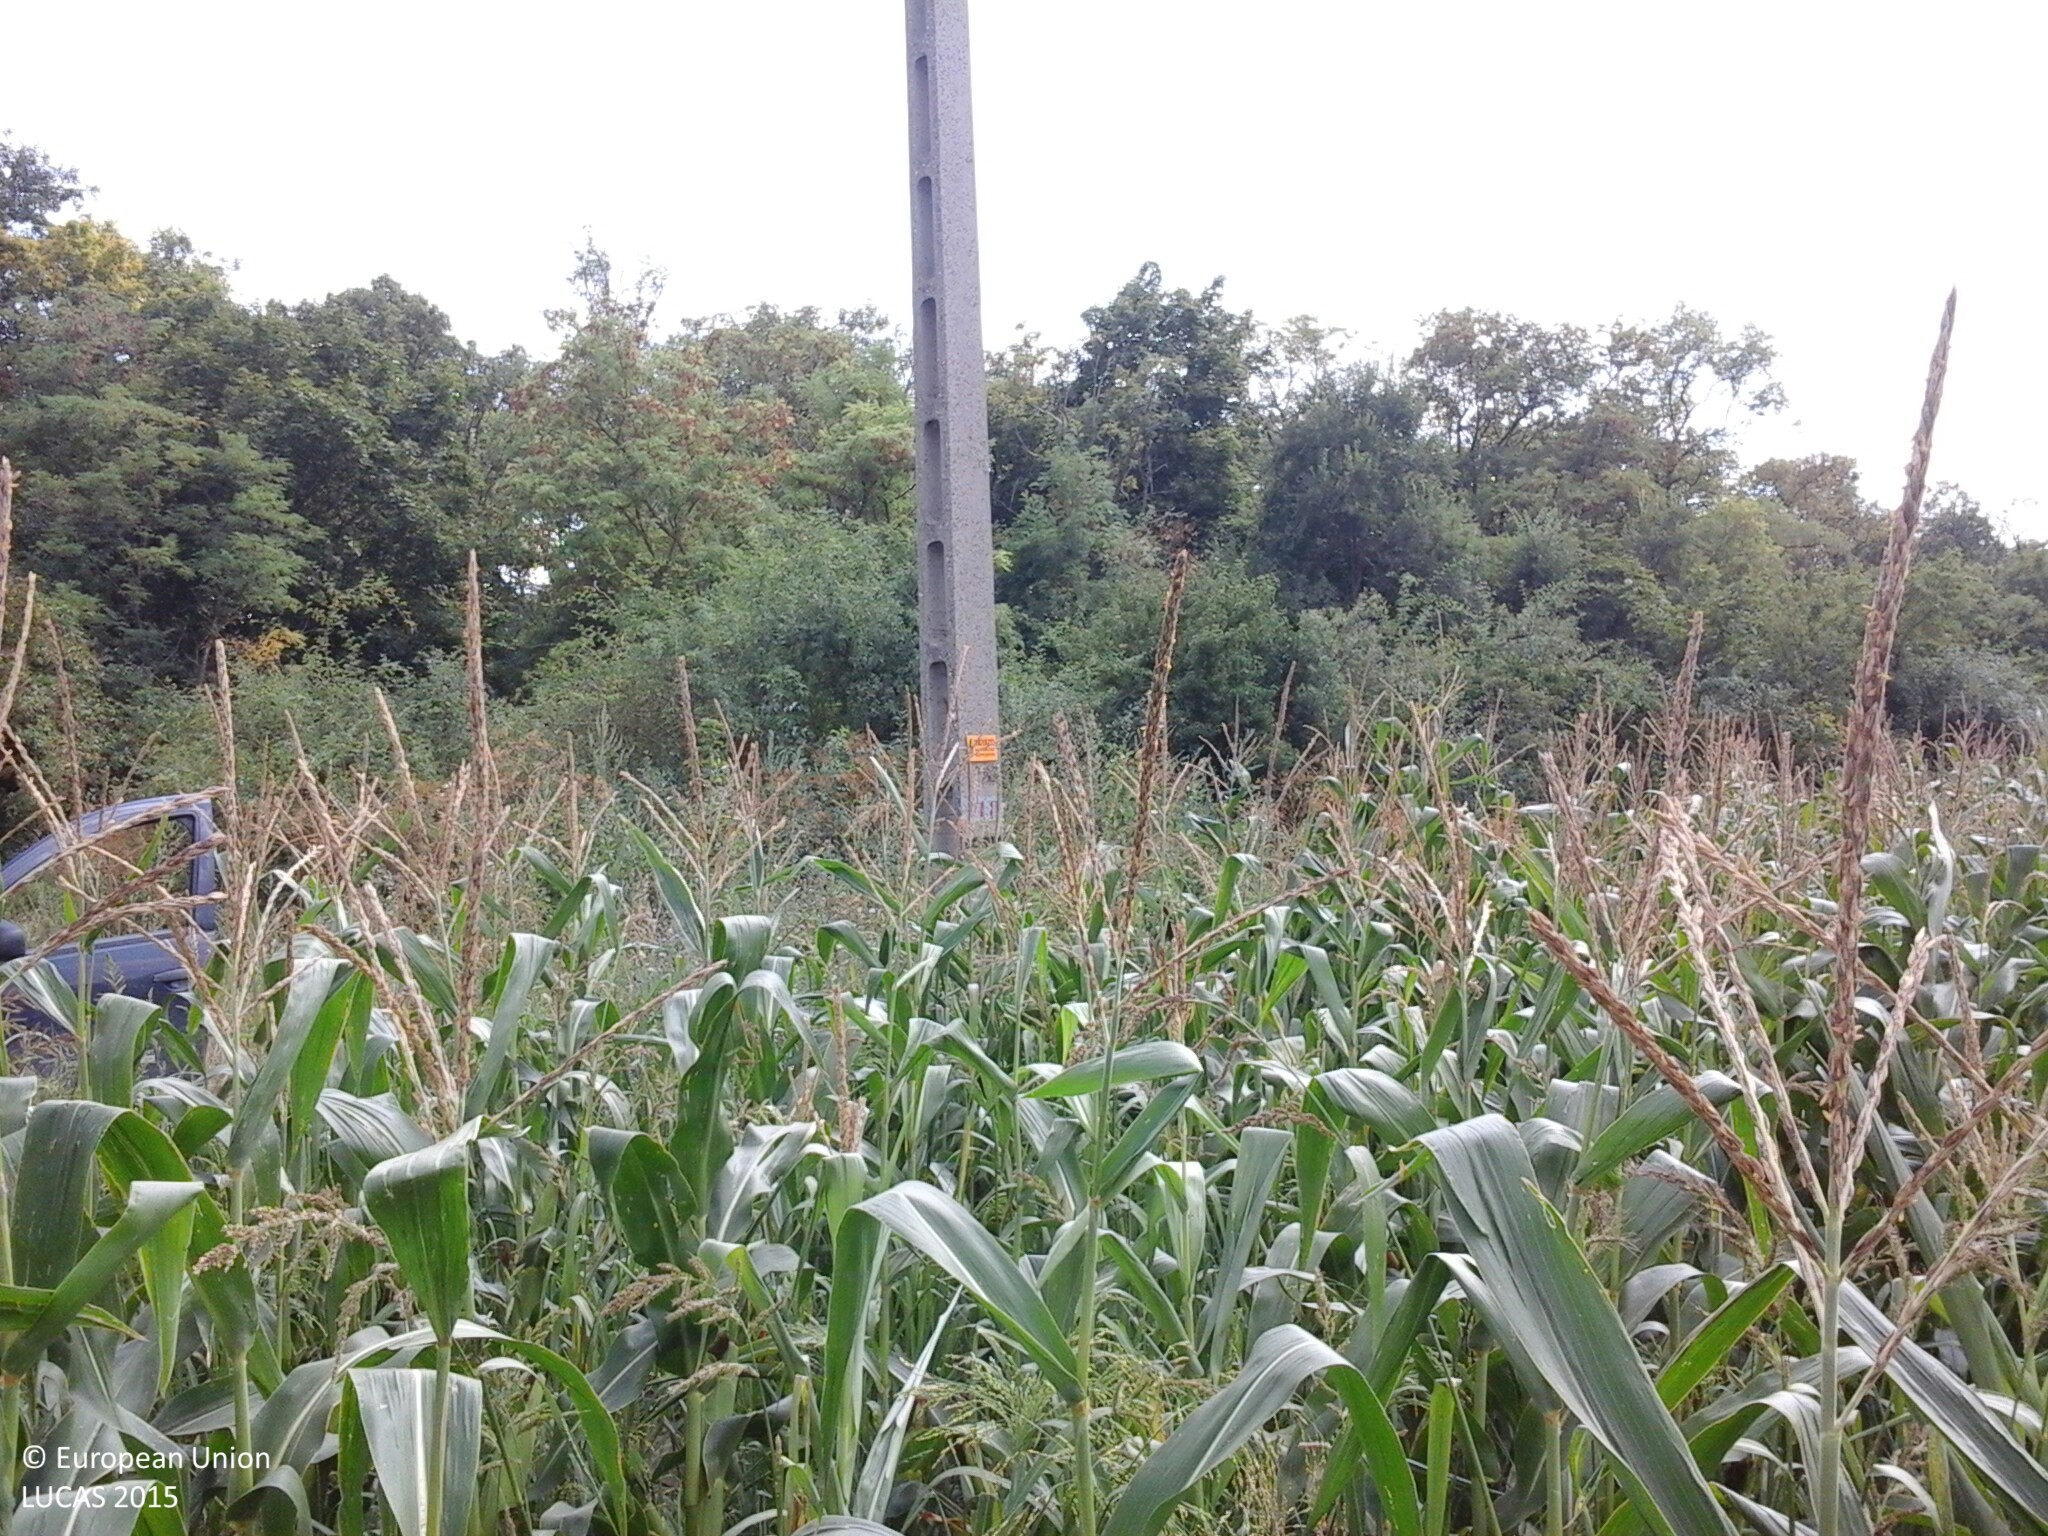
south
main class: Cropland
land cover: Maize
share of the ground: > 75 %
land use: Agriculture (excluding fallow land and kitchen gardens)
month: August
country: HU
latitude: 47.0347
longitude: 18.1560
